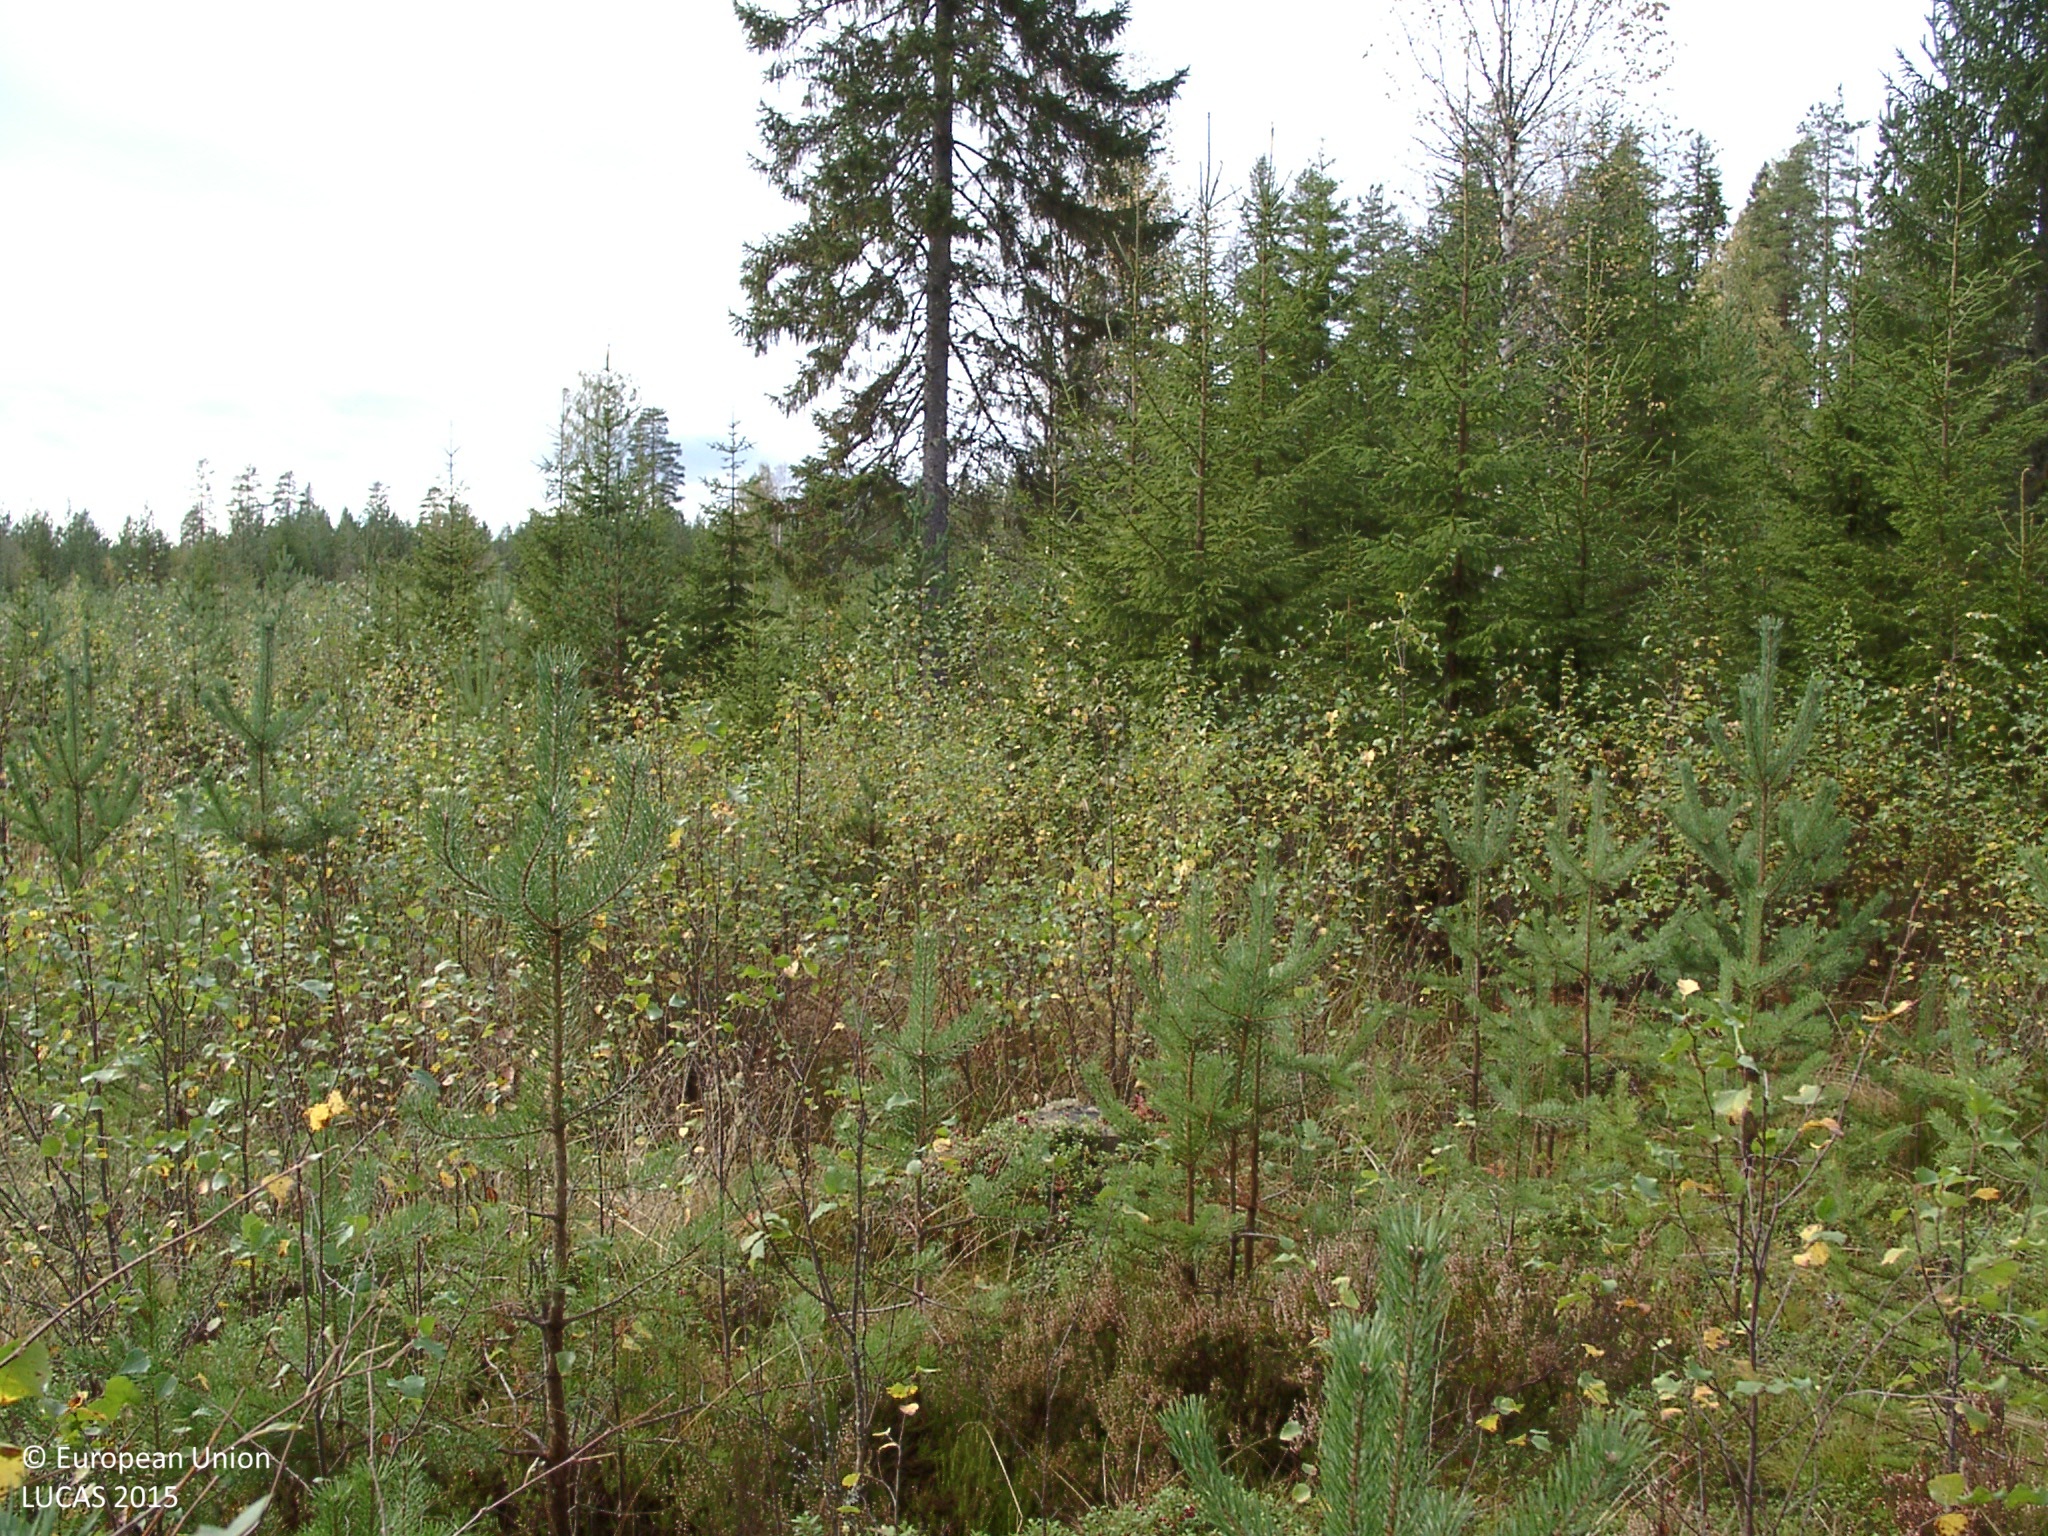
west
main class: Woodland
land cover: Pine dominated mixed woodland
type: boreal forest
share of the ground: 25 - 50 %
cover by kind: shrubs 50 %, broadleaved forest trees 20 %, coniferous forest trees 10 %, herbaceous plants 10 %, lichens and mosses 10 %
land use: Forestry
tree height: < 5 m
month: September
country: FI
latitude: 62.7221
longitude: 25.7022
